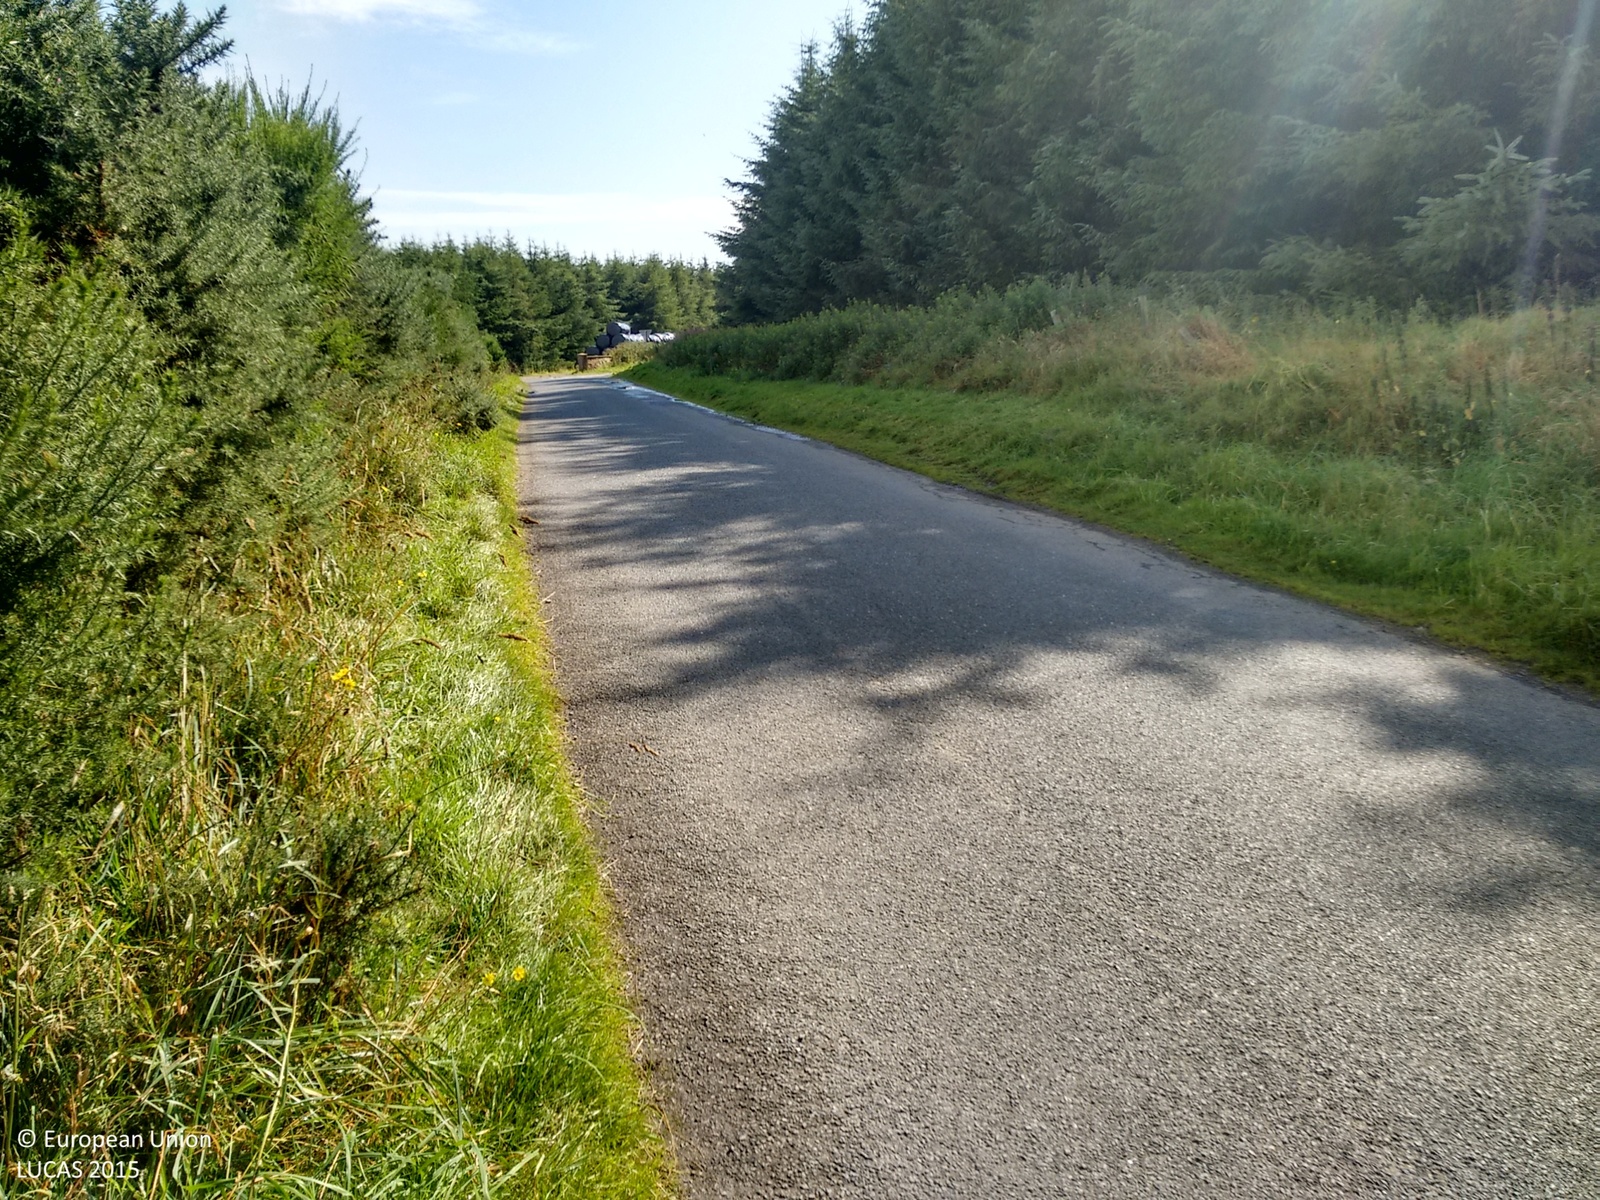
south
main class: Shrubland
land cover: Shrubland without tree cover
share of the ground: > 75 %
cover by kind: shrubs 100 %
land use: Agriculture (excluding fallow land and kitchen gardens)
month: August
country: GB
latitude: 57.4638
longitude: -2.1673
